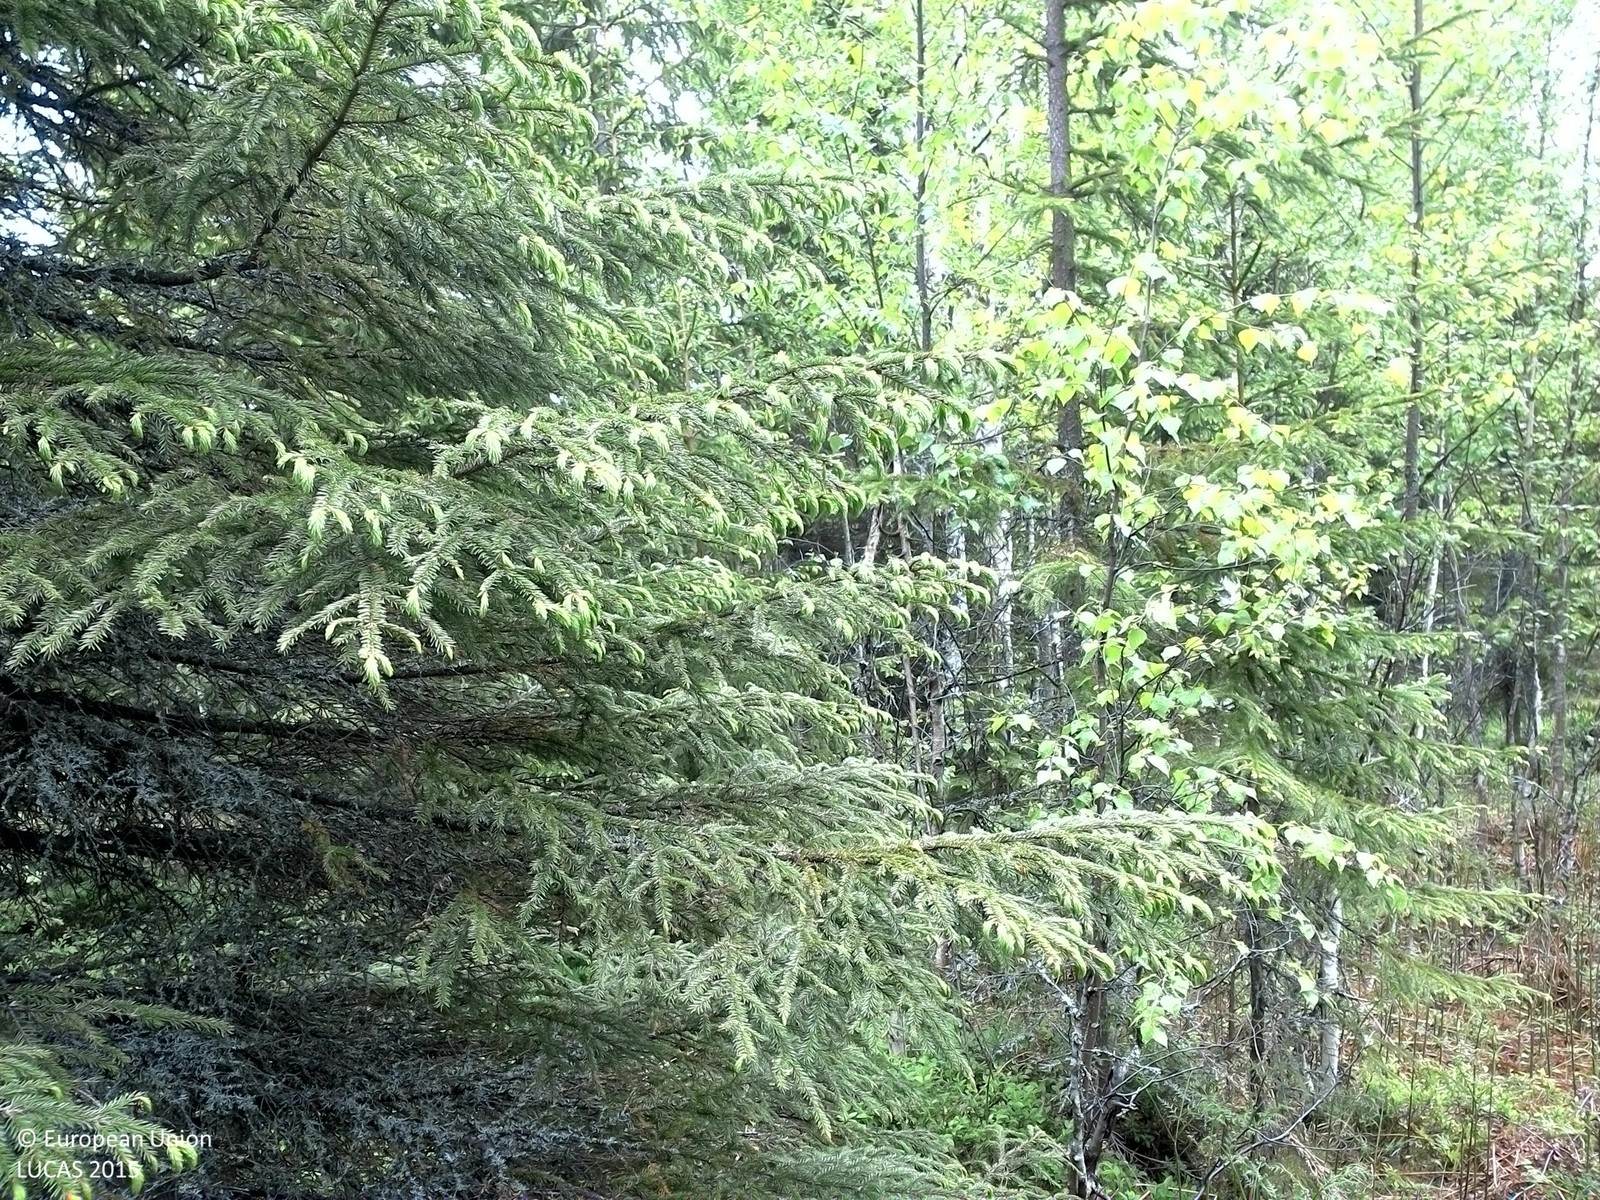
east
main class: Woodland
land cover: Spruce dominated mixed woodland
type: boreal forest
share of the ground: 50 - 75 %
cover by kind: coniferous forest trees 45 %, shrubs 30 %, broadleaved forest trees 15 %, herbaceous plants 10 %
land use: Forestry
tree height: > 5 m
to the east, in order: Spruce dominated mixed woodland; Spruce dominated coniferous woodland; Tracks; Spruce dominated mixed woodland; Spruce dominated coniferous woodland
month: June
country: SE
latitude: 62.7609
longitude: 17.6754
